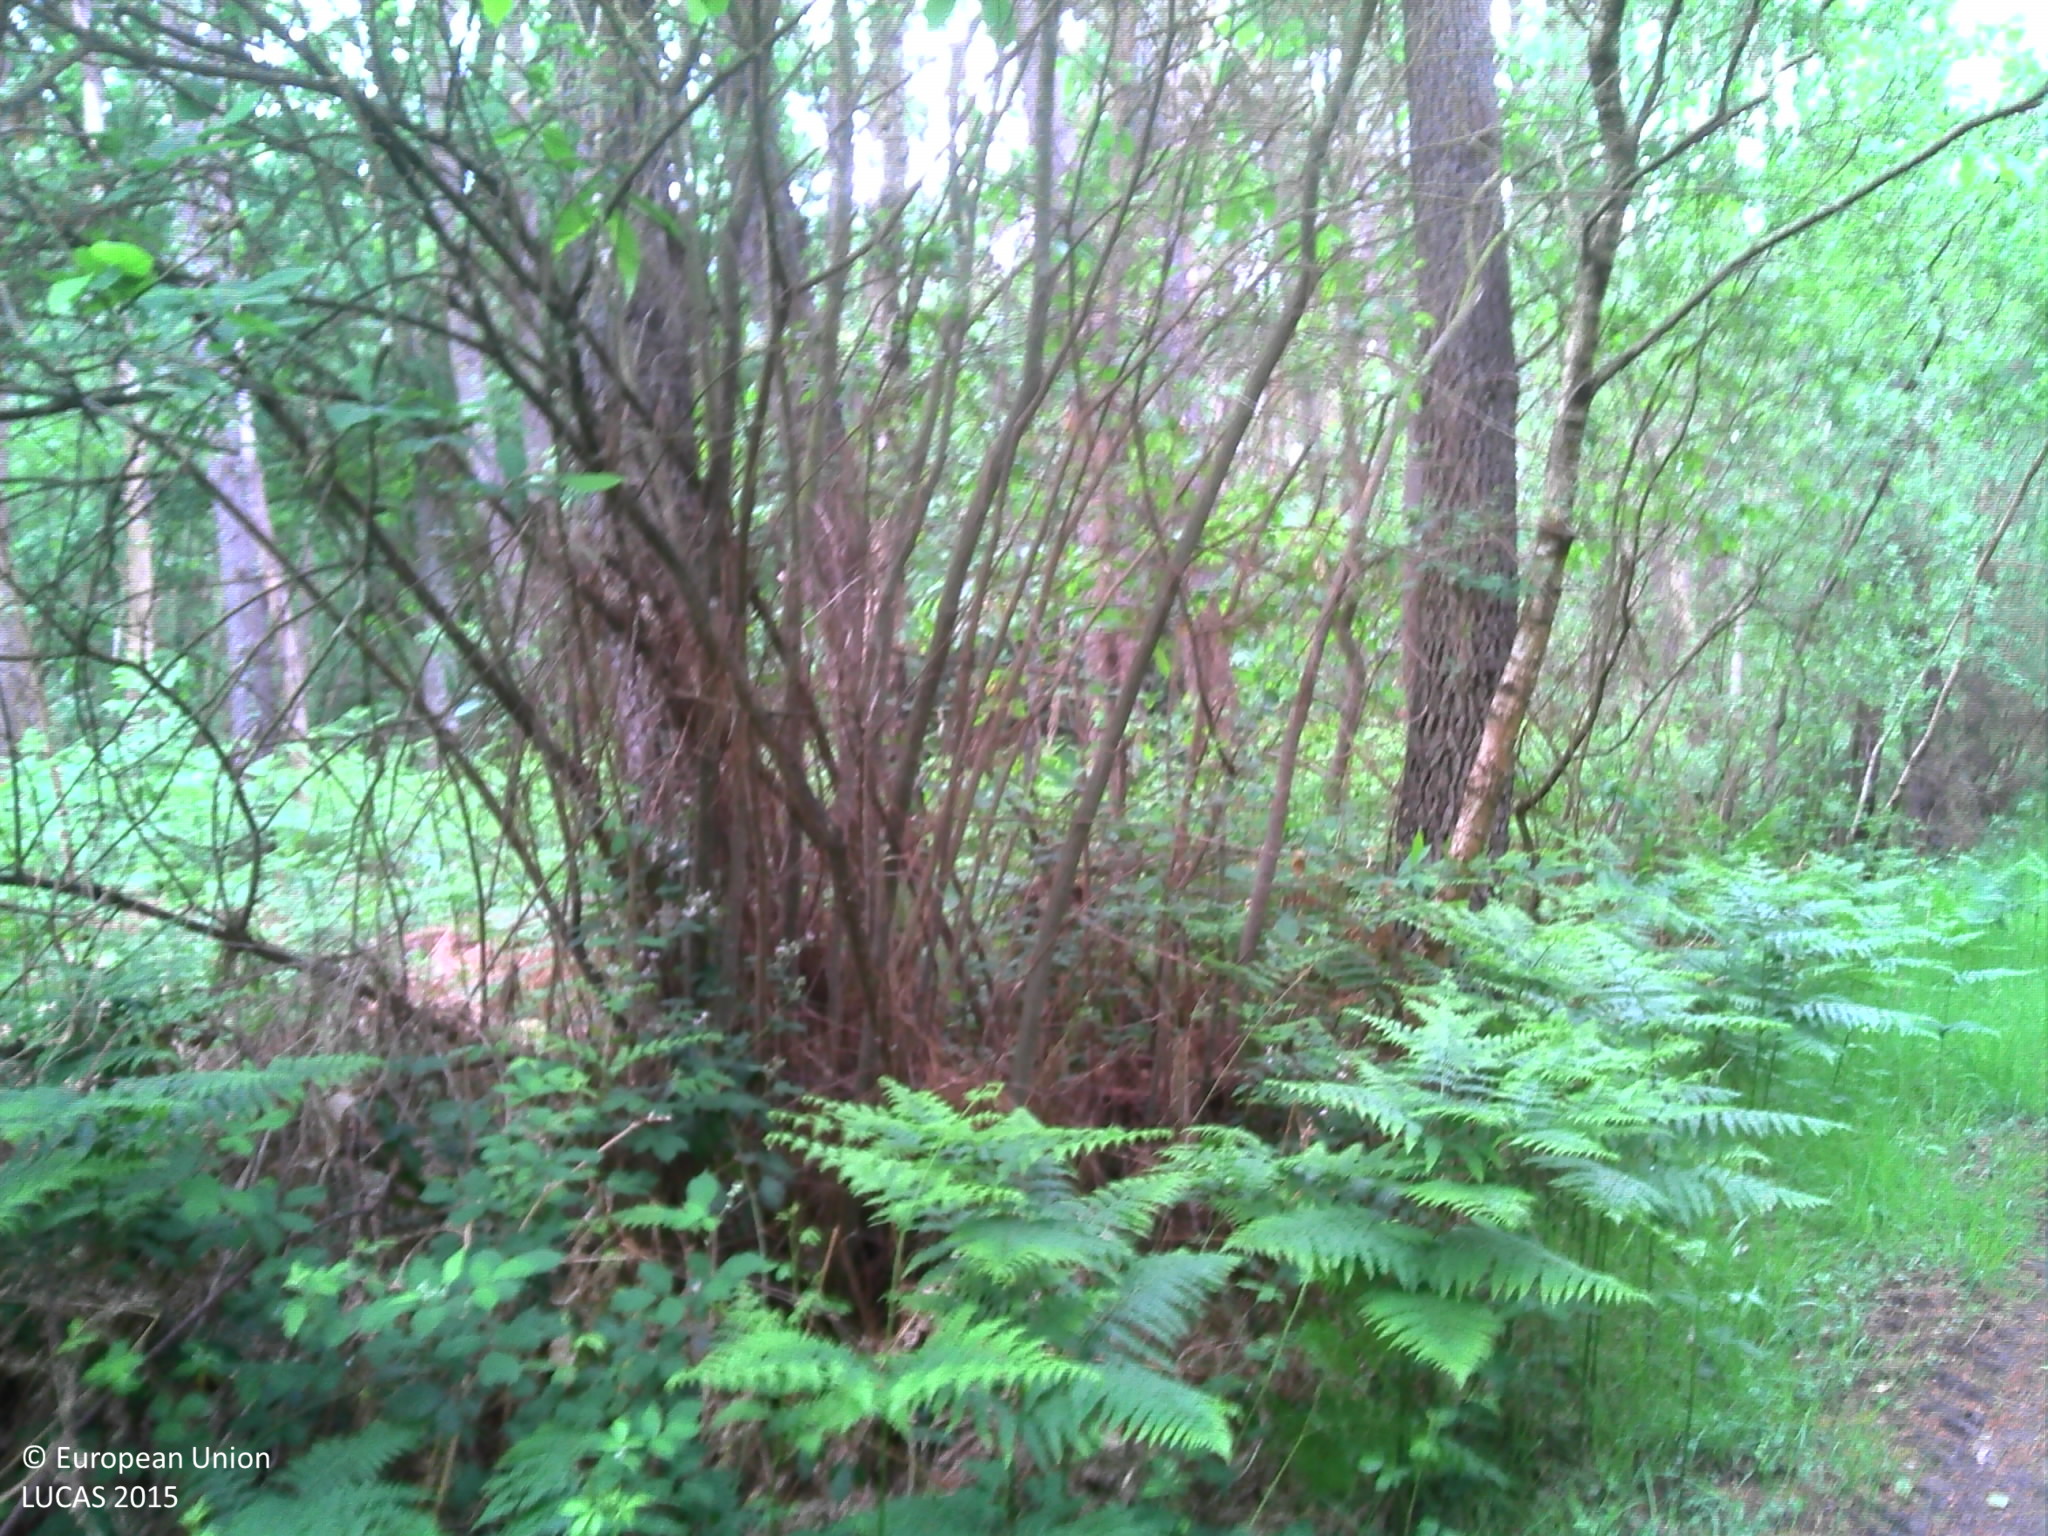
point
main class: Woodland
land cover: Pine dominated mixed woodland
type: mesophytic deciduous forest
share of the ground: > 75 %
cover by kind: broadleaved forest trees 40 %, coniferous forest trees 35 %, herbaceous plants 15 %, lichens and mosses 5 %, unconsolidated bare surface 5 %
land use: Forestry
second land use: Sport
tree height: > 5 m
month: June
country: FR
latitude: 47.6412
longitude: 0.0037
